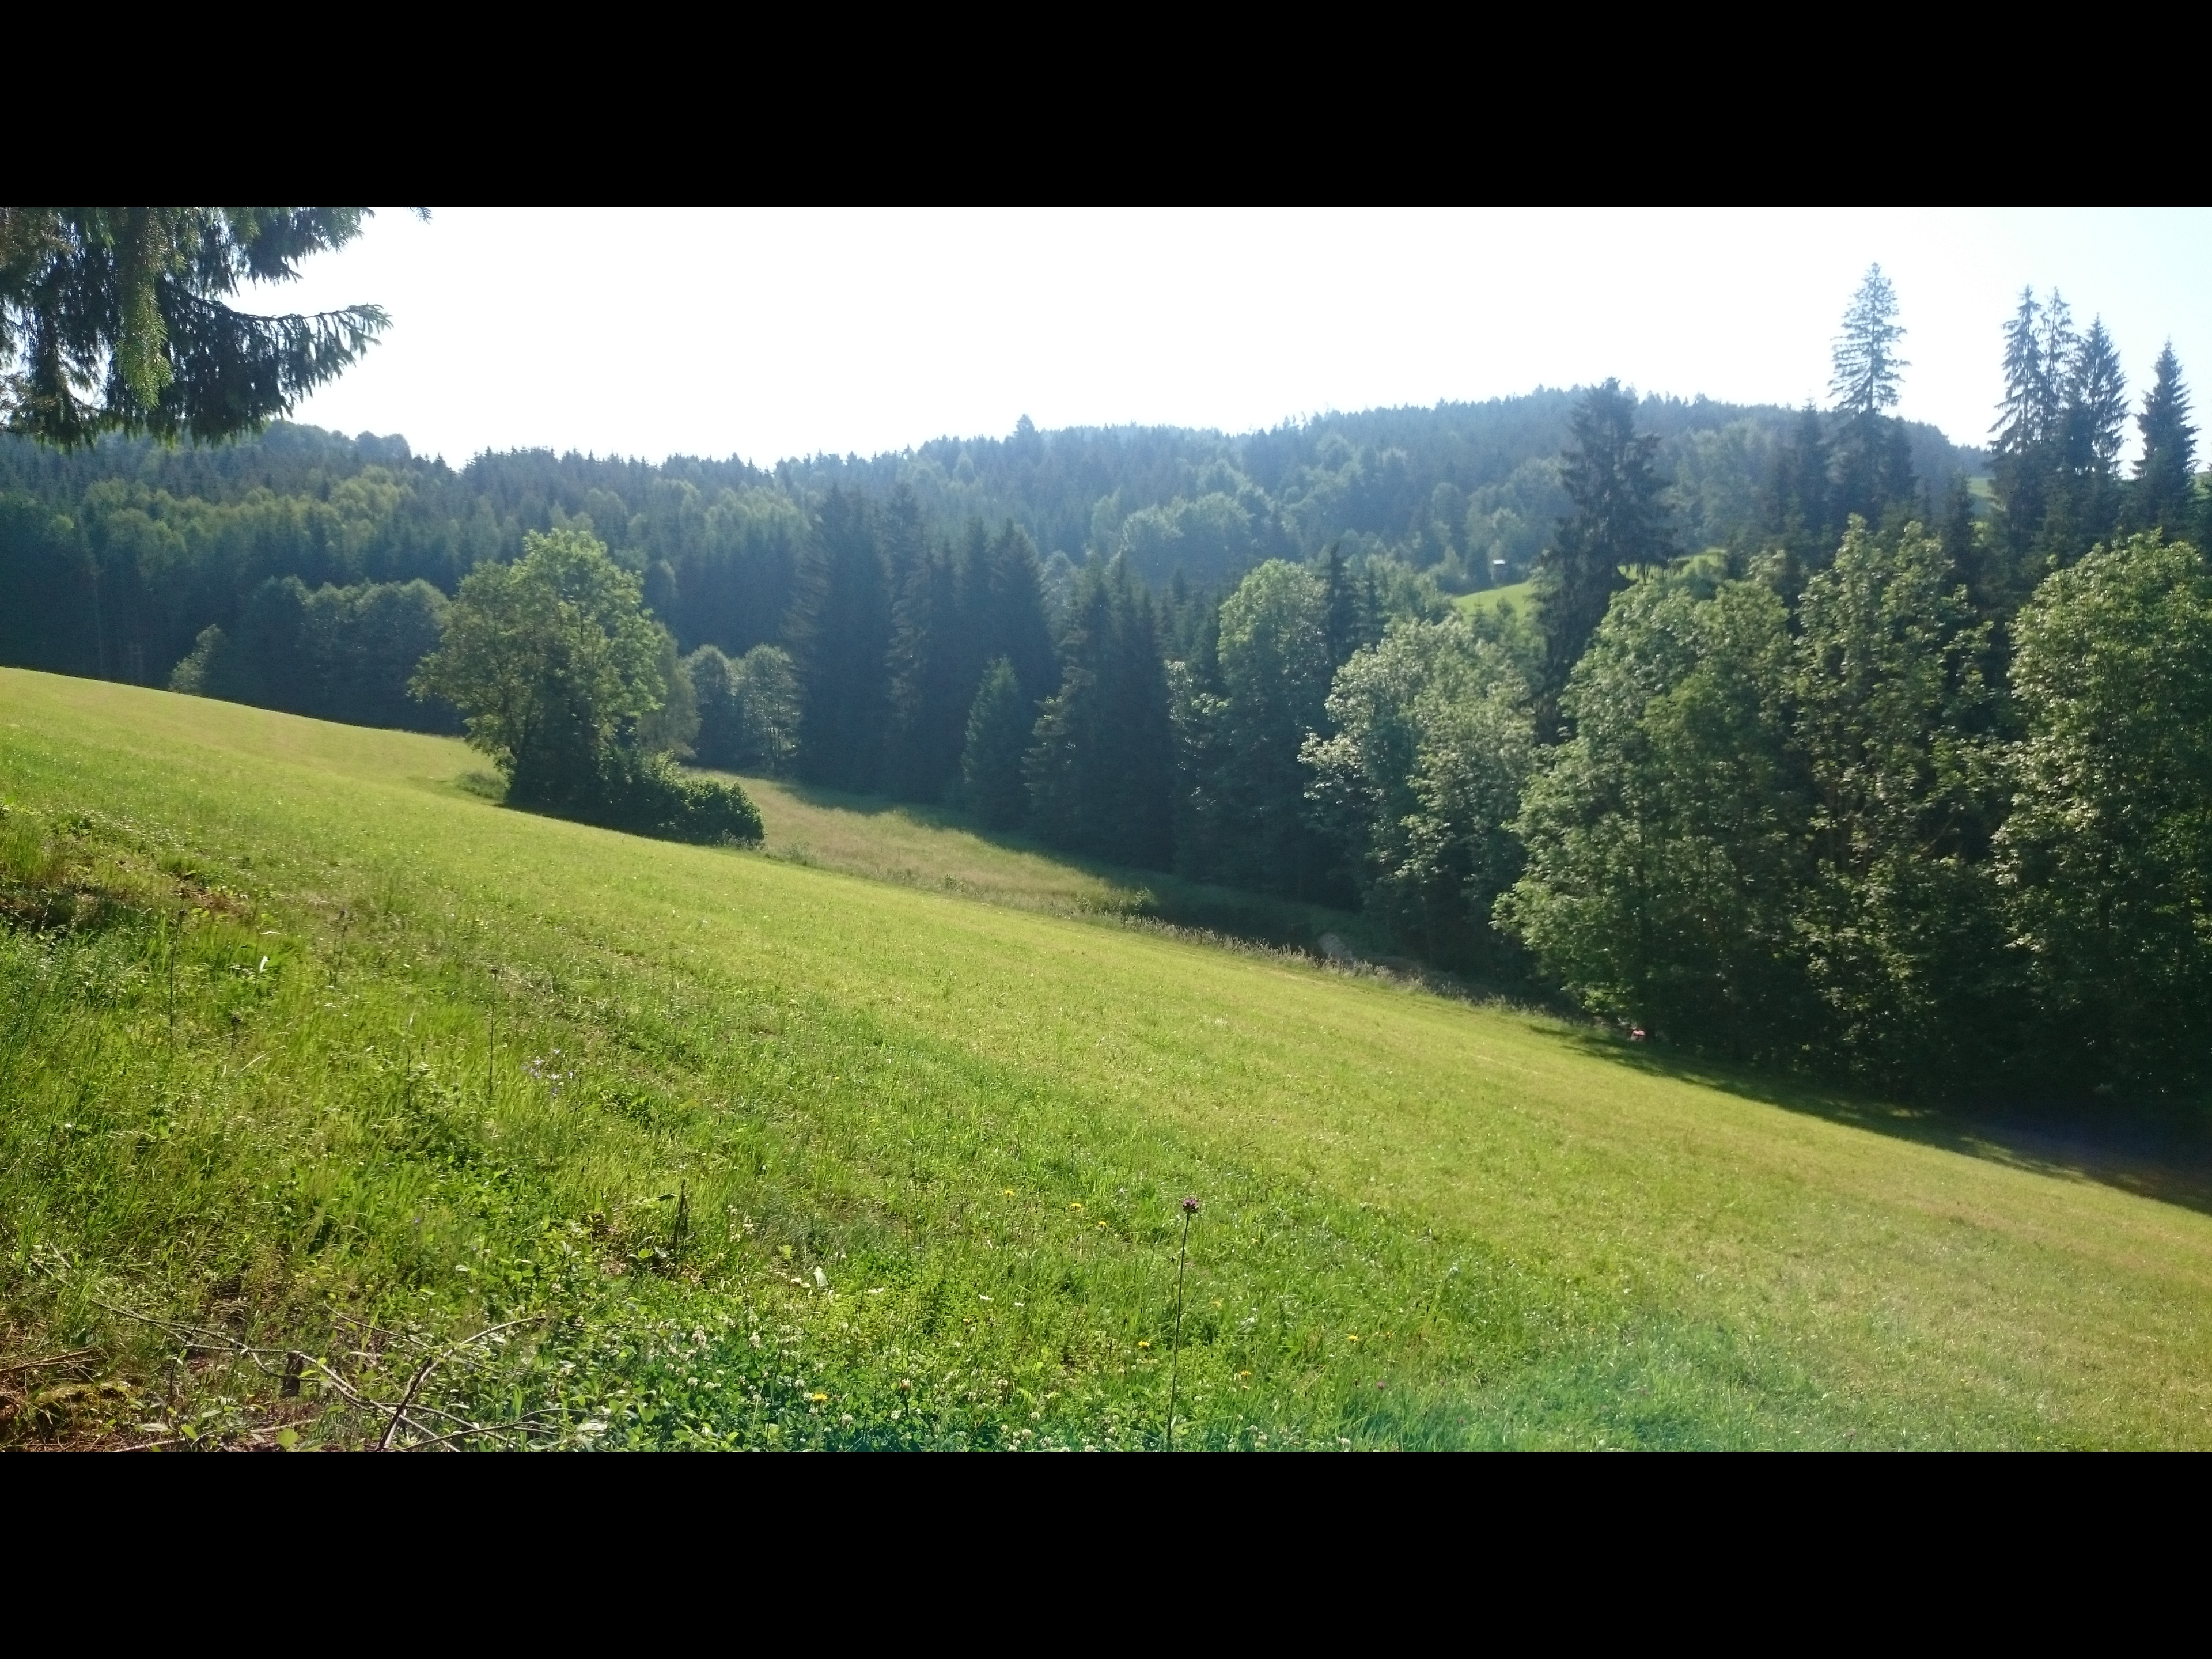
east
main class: Woodland
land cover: Spruce dominated coniferous woodland
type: hemiboreal forest and nemoral coniferous forest and mixed broadleaved-coniferous forest
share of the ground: > 75 %
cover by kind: coniferous forest trees 75 %, unconsolidated bare surface 25 %
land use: Forestry
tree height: > 5 m
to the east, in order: Spruce dominated coniferous woodland; Fences; Grassland without tree/shrub cover; Broadleaved woodland; Grassland without tree/shrub cover; Tracks; Broadleaved woodland; Rivers and streams; Spruce dominated mixed woodland; Spruce dominated coniferous woodland
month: June
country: AT
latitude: 48.4695
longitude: 14.6131
